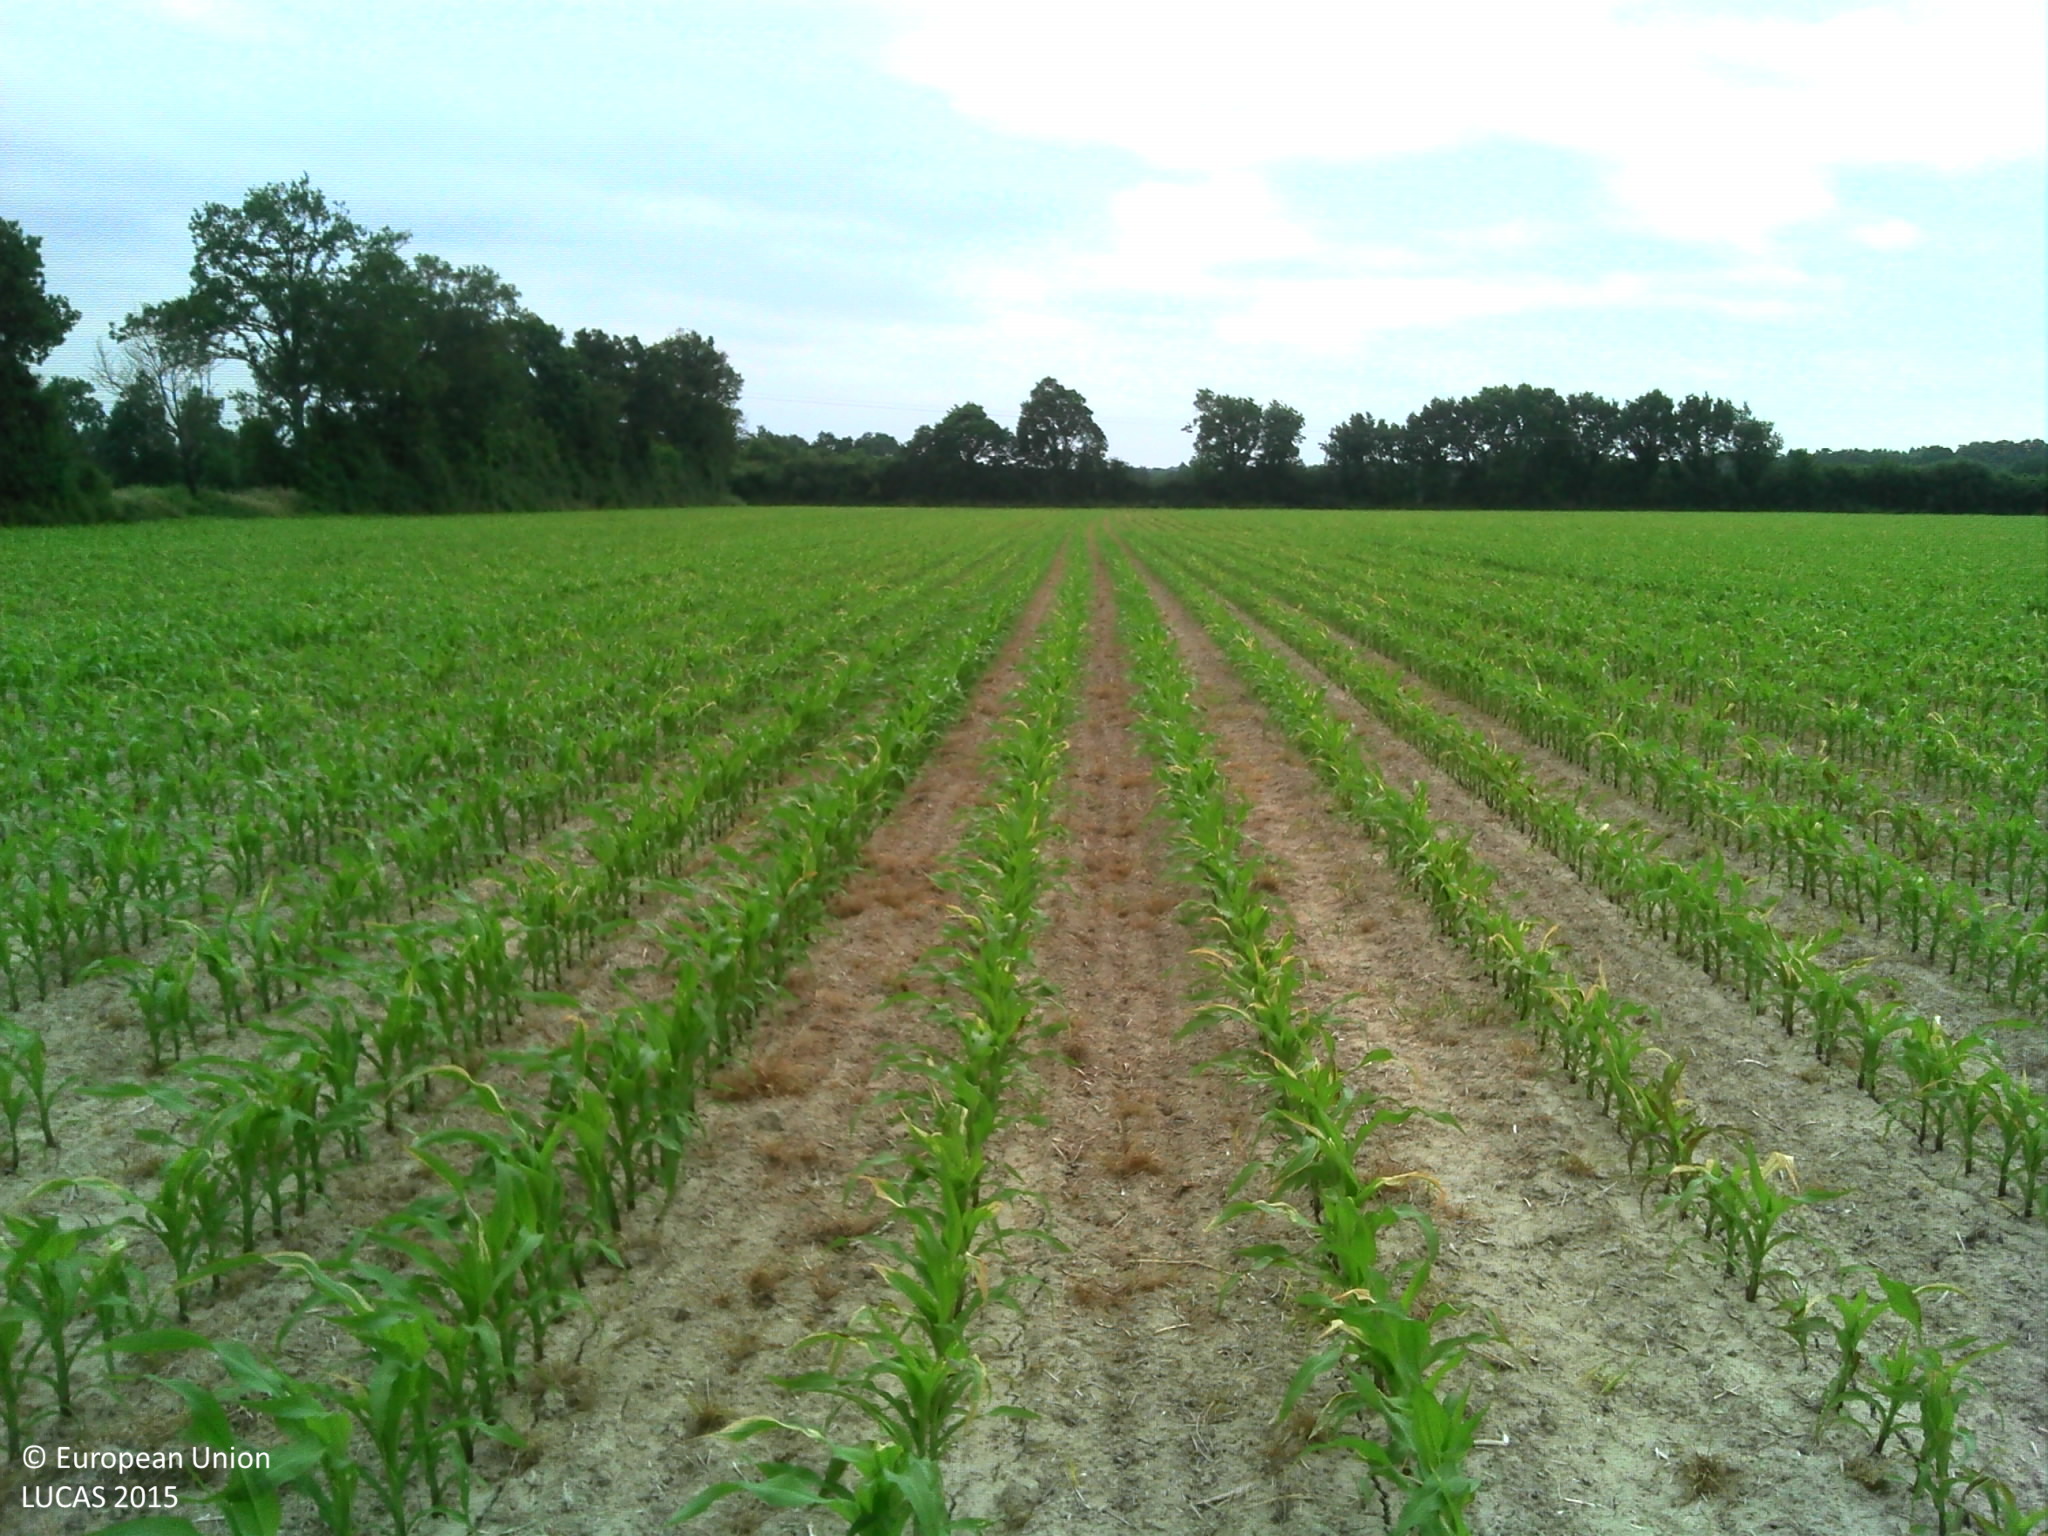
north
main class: Cropland
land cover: Maize
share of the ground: 25 - 50 %
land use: Agriculture (excluding fallow land and kitchen gardens)
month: June
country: FR
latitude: 47.0020
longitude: -1.4954
